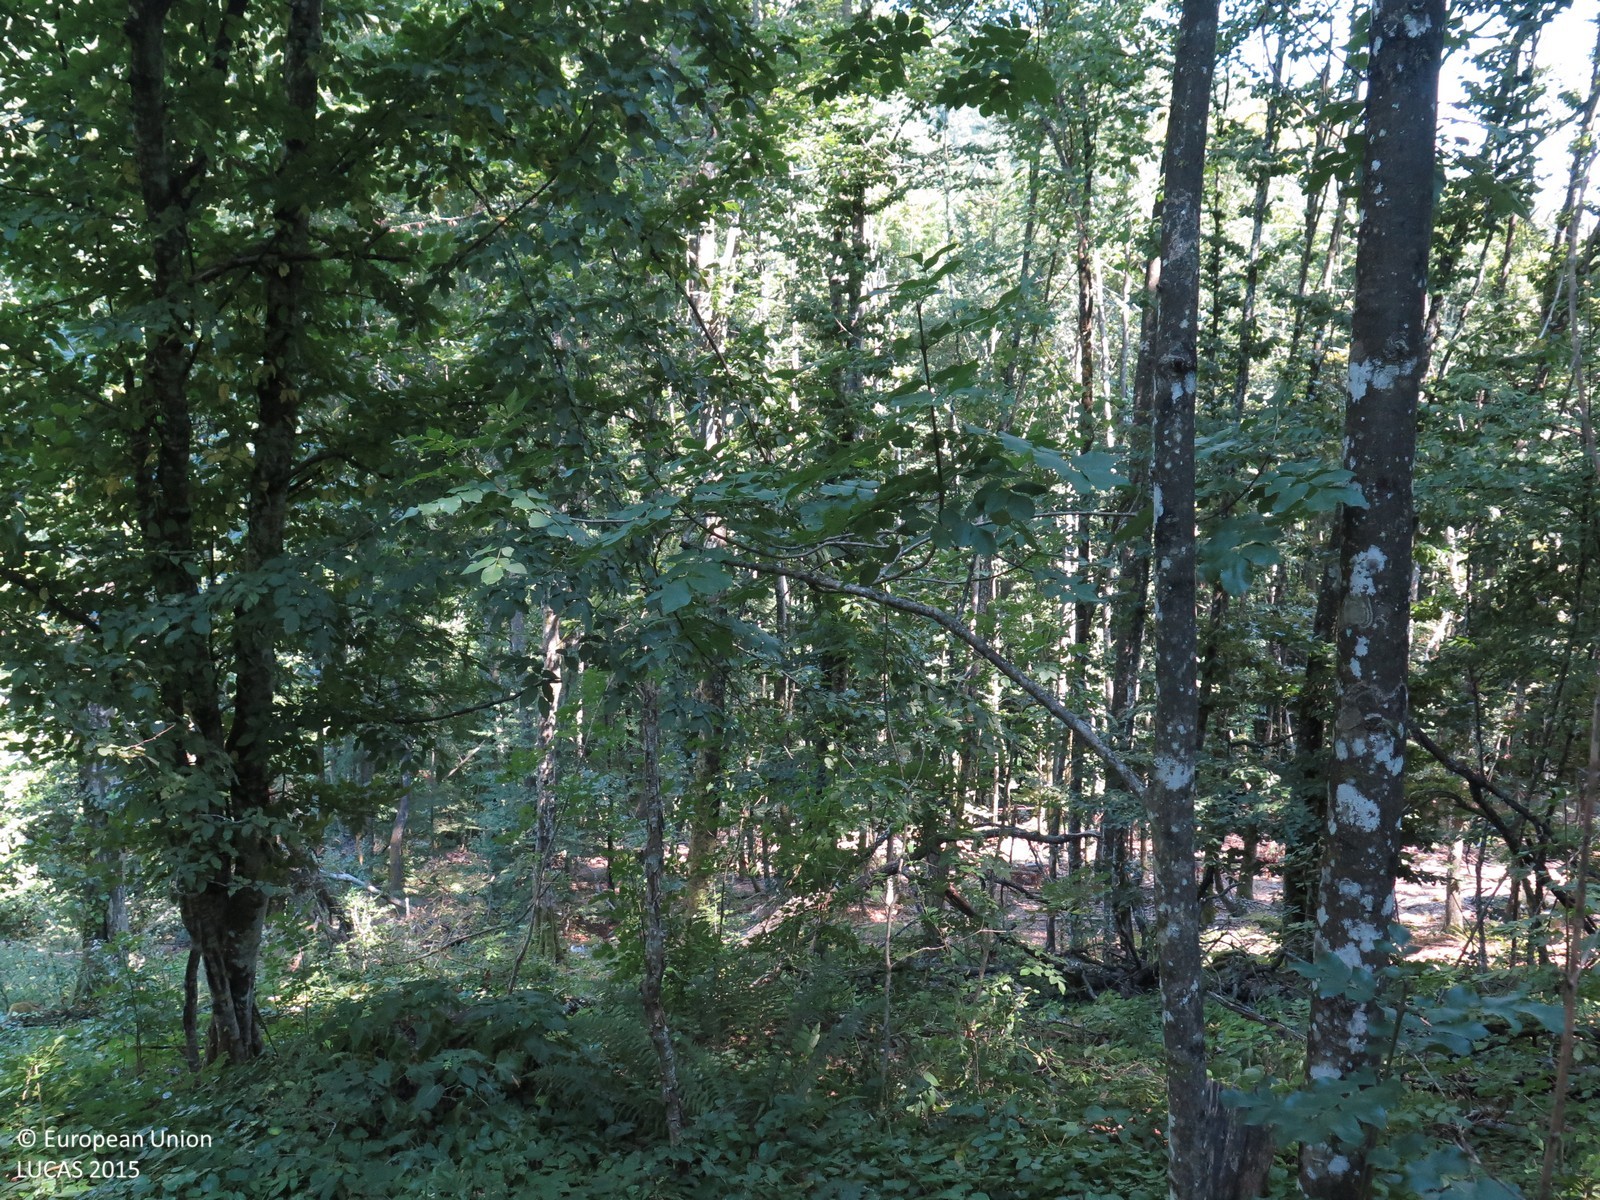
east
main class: Woodland
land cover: Broadleaved woodland
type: beech forest
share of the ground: > 75 %
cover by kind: broadleaved forest trees 95 %, herbaceous plants 5 %
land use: Semi-natural and natural areas not in use
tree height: > 5 m
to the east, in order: Broadleaved woodland; Tracks; Inland fresh running water
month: August
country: HR
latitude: 45.4306
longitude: 15.1979
